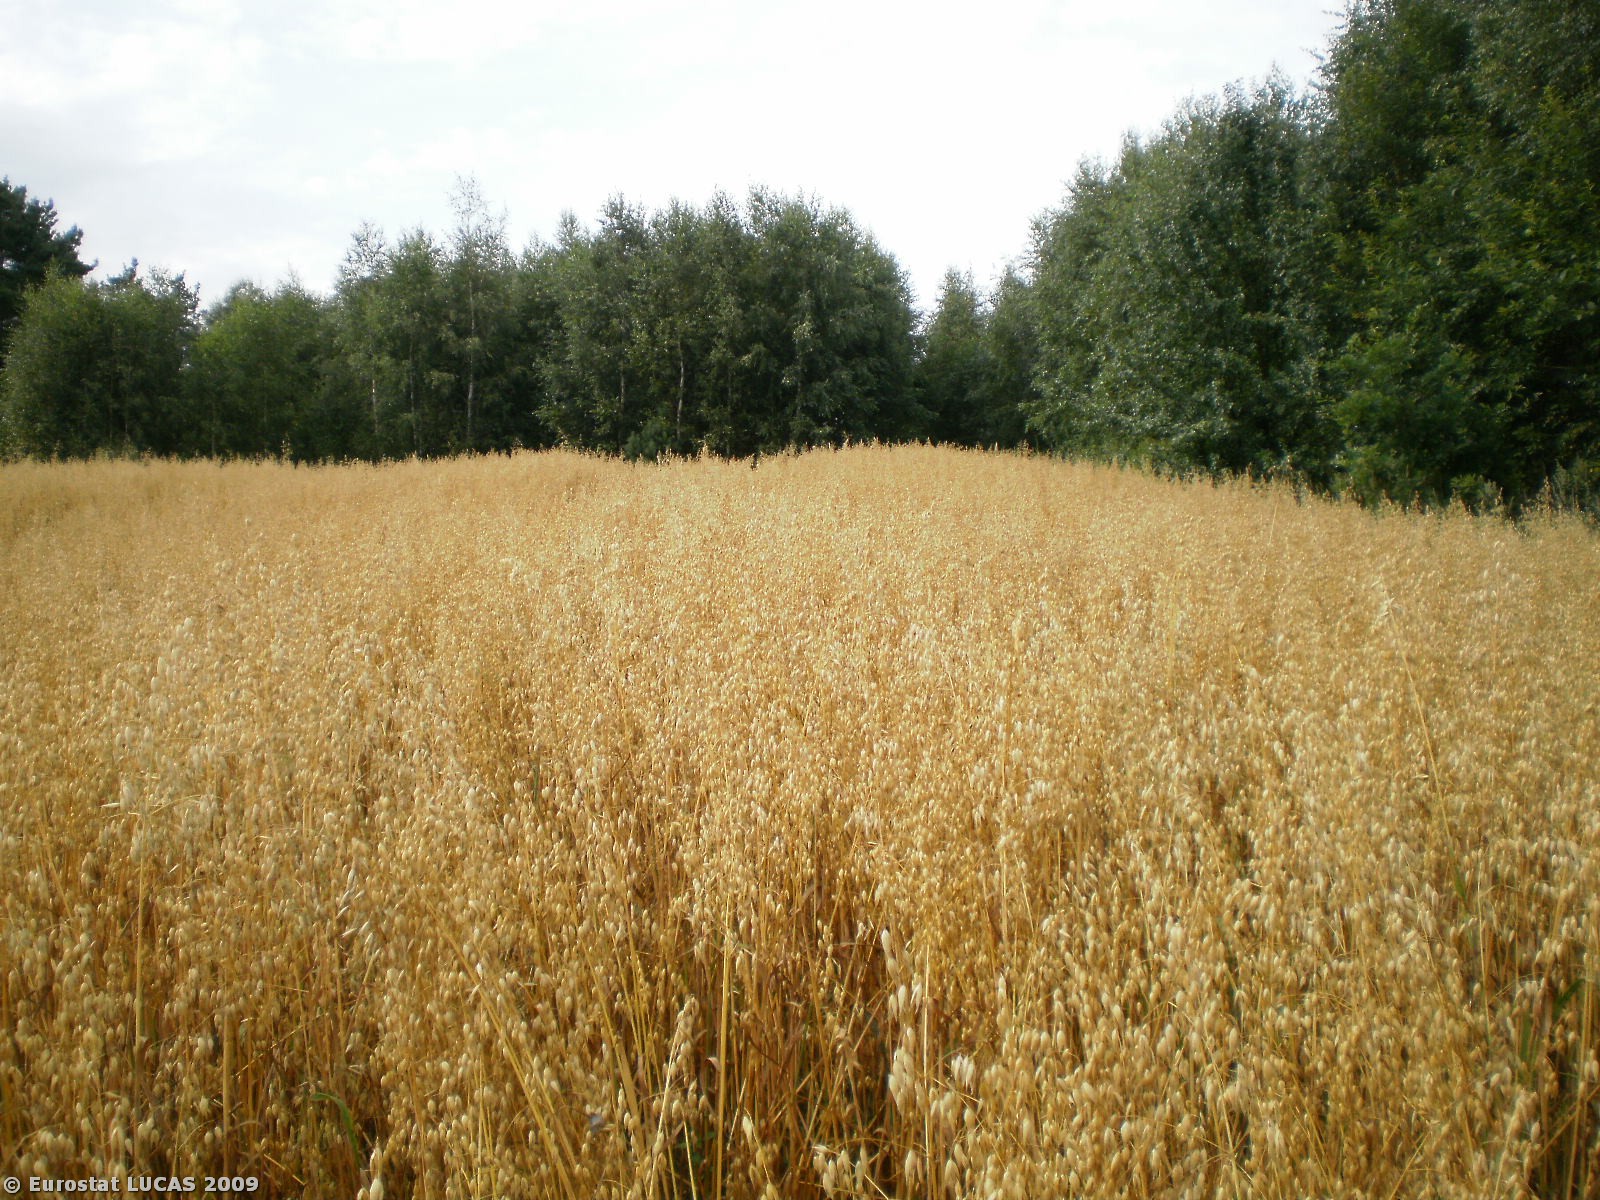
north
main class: Cropland
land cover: Oats
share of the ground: > 75 %
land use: Agriculture (excluding fallow land and kitchen gardens)
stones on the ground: < 10 %
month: August
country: PL
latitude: 54.1288
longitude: 20.6430
